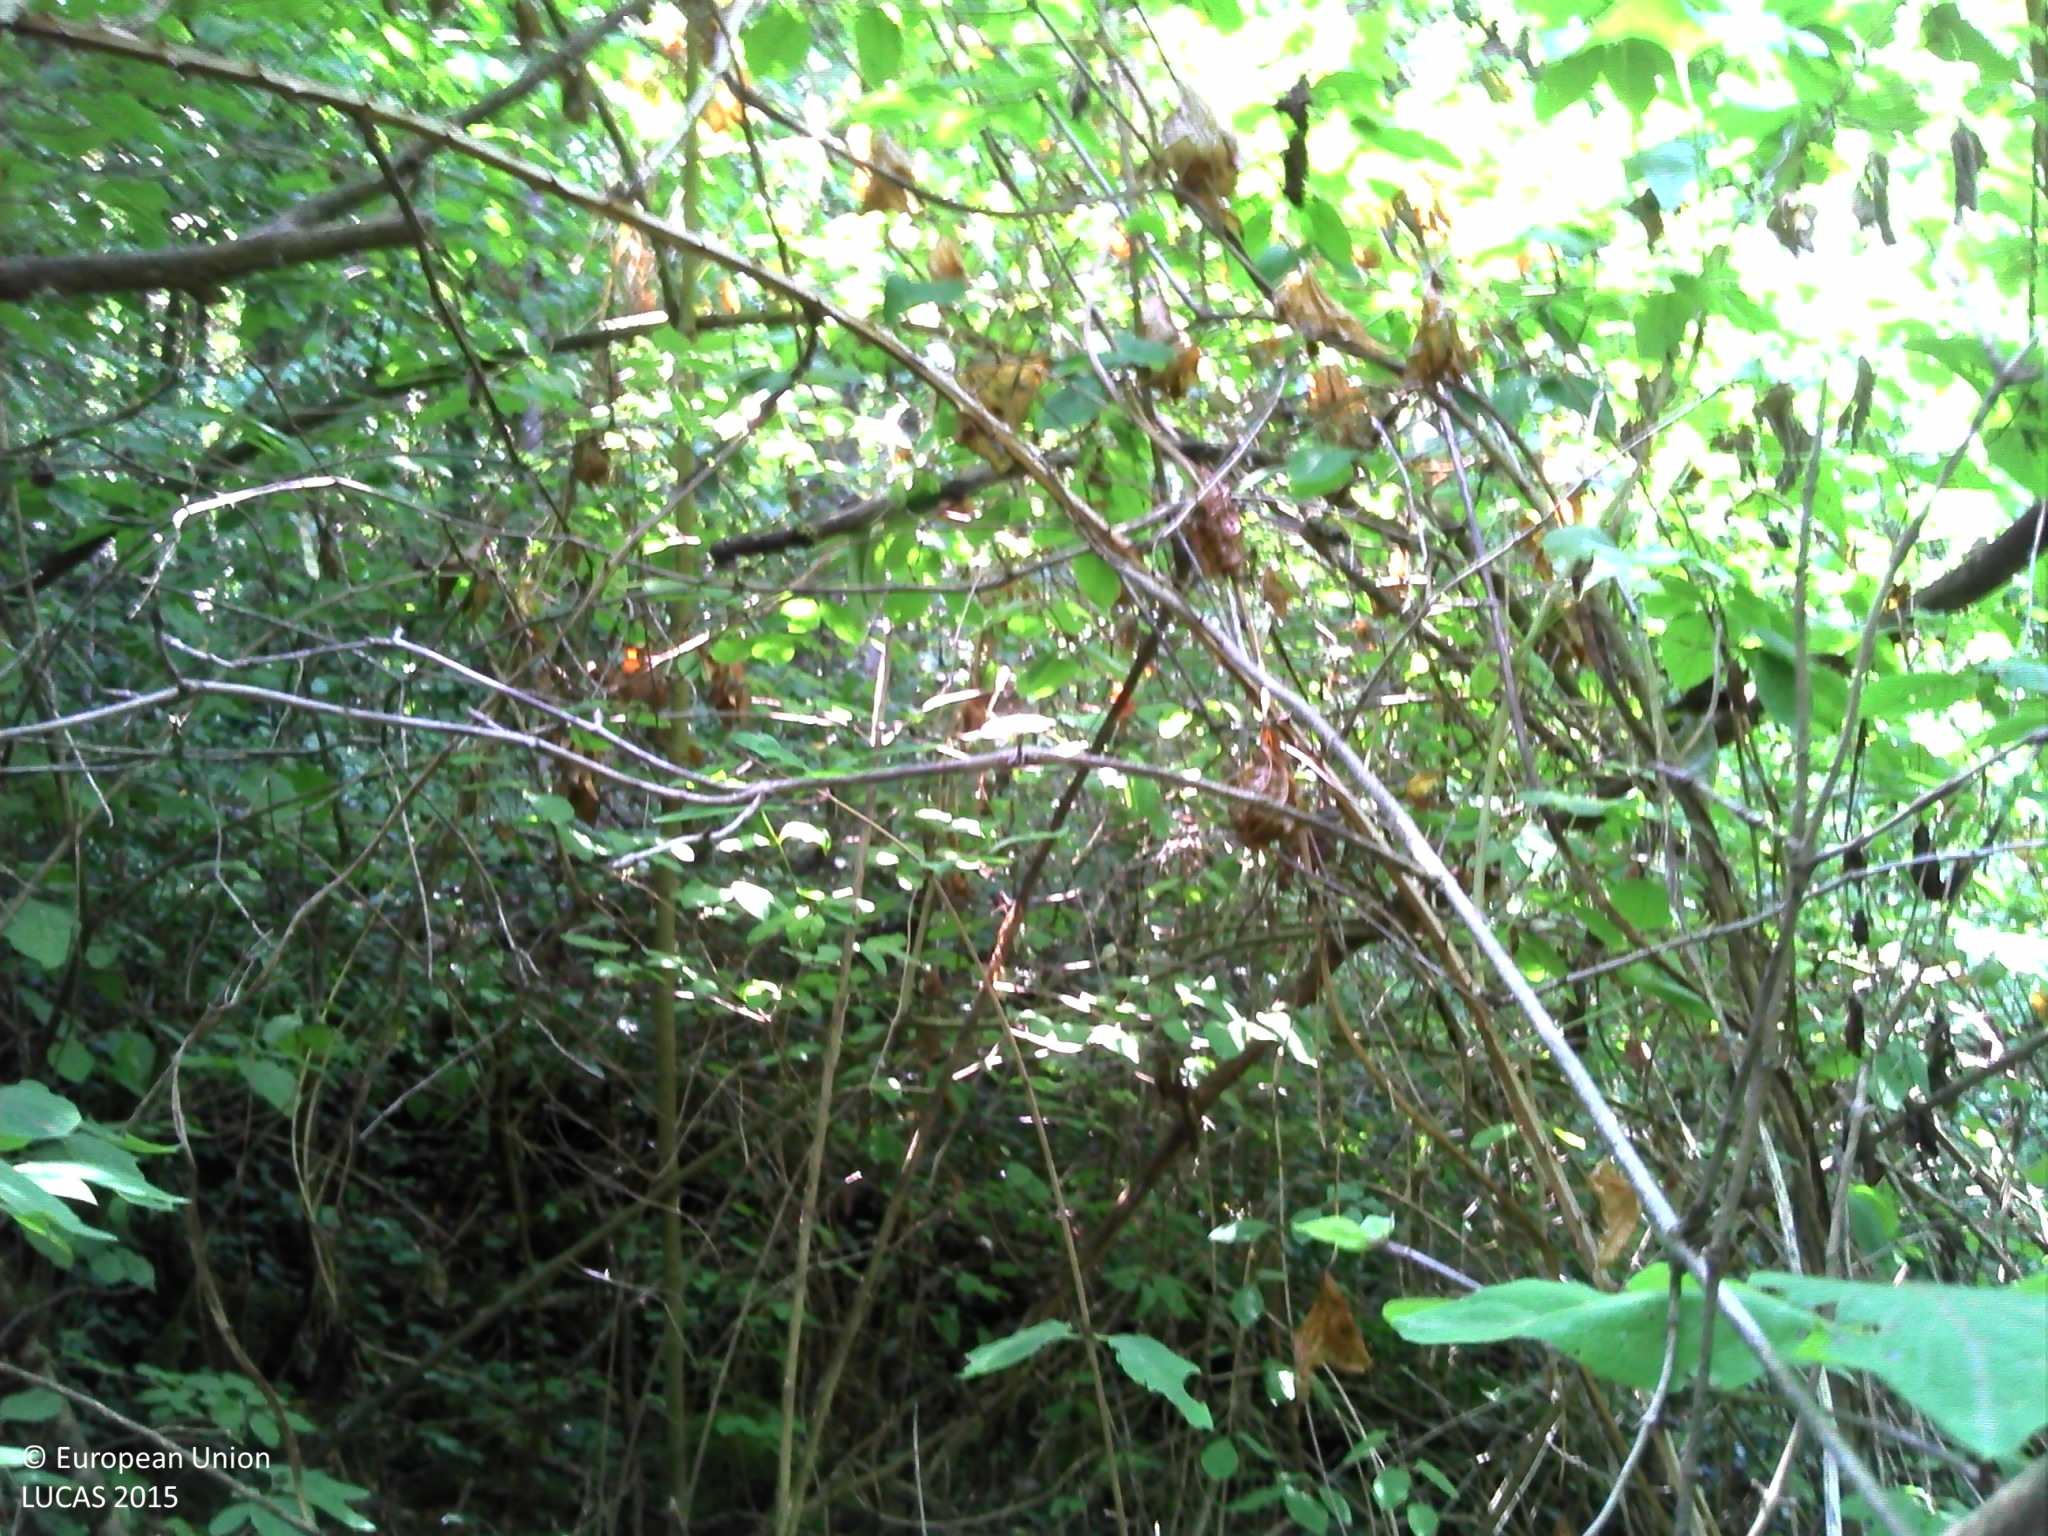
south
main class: Woodland
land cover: Pine dominated mixed woodland
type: hemiboreal forest and nemoral coniferous forest and mixed broadleaved-coniferous forest
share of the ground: > 75 %
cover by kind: coniferous forest trees 60 %, broadleaved forest trees 30 %, herbaceous plants 5 %, lichens and mosses 5 %
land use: Forestry
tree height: > 5 m
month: August
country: FR
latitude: 47.8667
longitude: 3.4580
